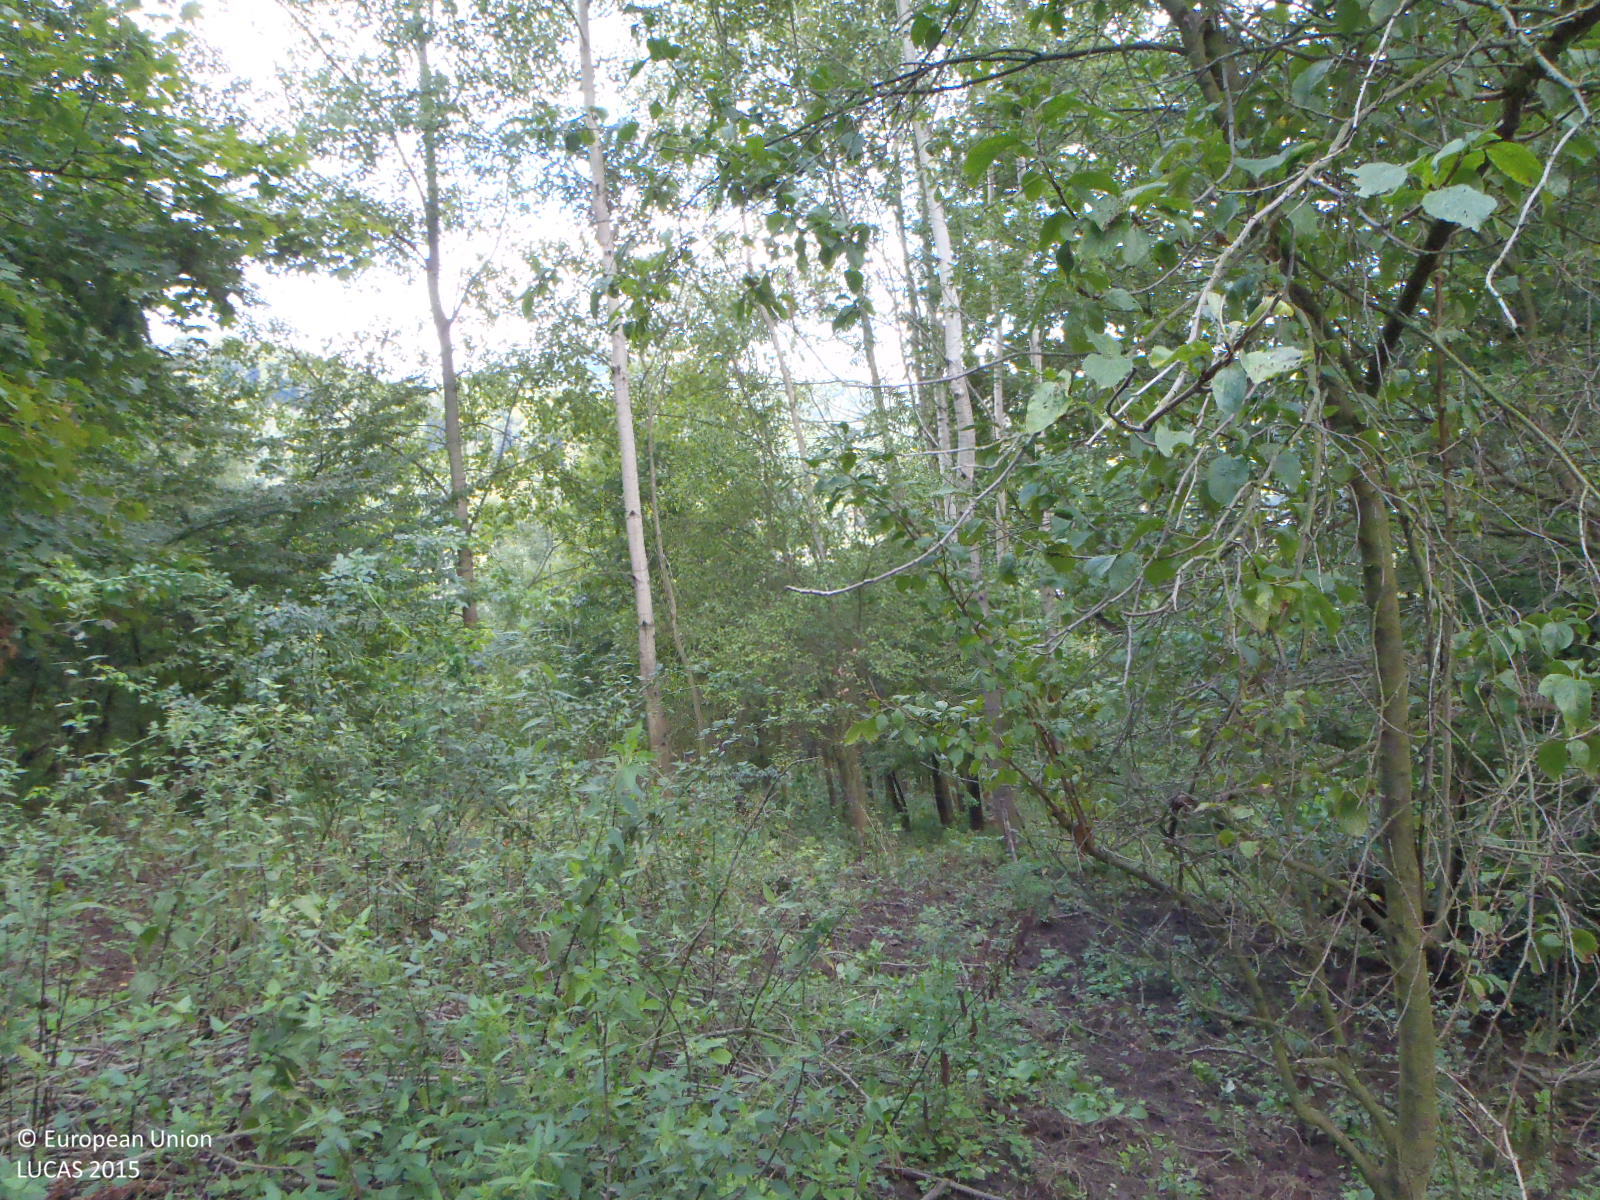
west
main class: Woodland
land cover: Broadleaved woodland
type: mesophytic deciduous forest
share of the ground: > 75 %
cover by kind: broadleaved forest trees 75 %, herbaceous plants 10 %, unconsolidated bare surface 10 %, shrubs 5 %
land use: Forestry
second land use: Agriculture (excluding fallow land and kitchen gardens)
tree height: > 5 m
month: September
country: CZ
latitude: 50.7009
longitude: 14.2064
